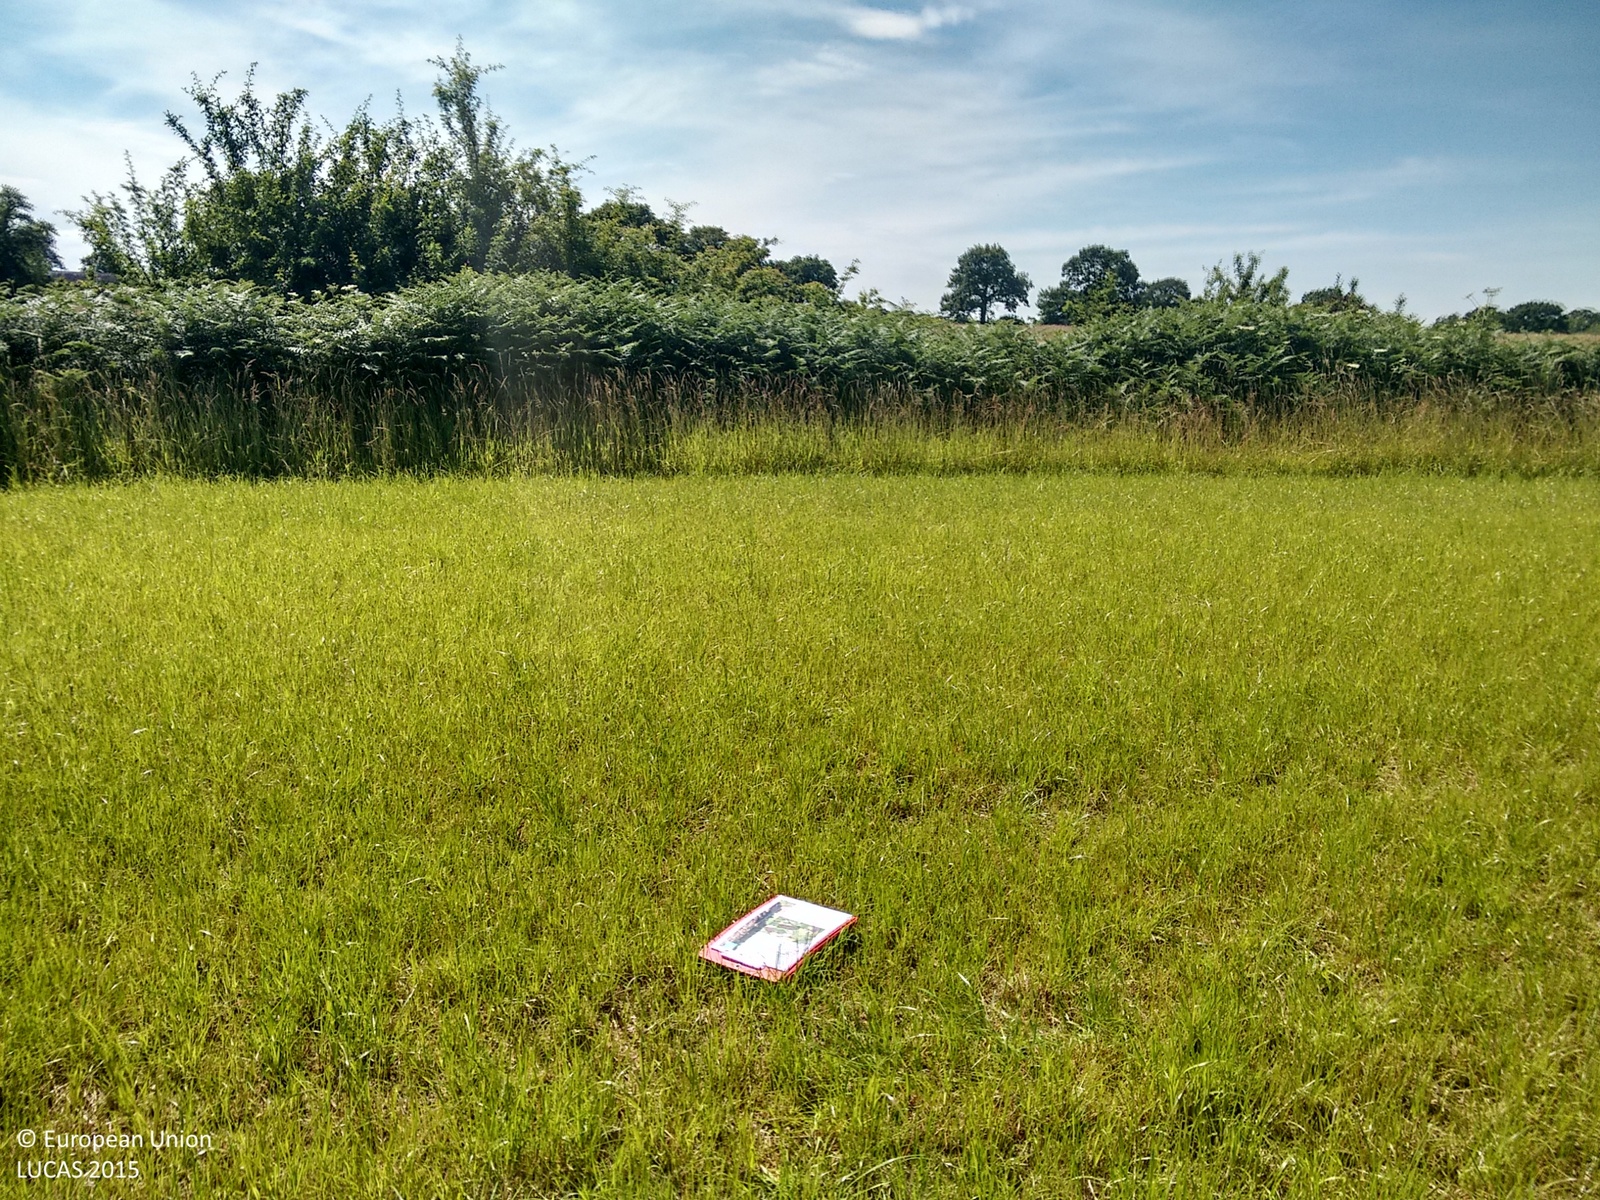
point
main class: Cropland
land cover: Temporary grasslands
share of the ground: > 75 %
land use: Agriculture (excluding fallow land and kitchen gardens)
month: July
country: GB
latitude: 53.3321
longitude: -2.5143
